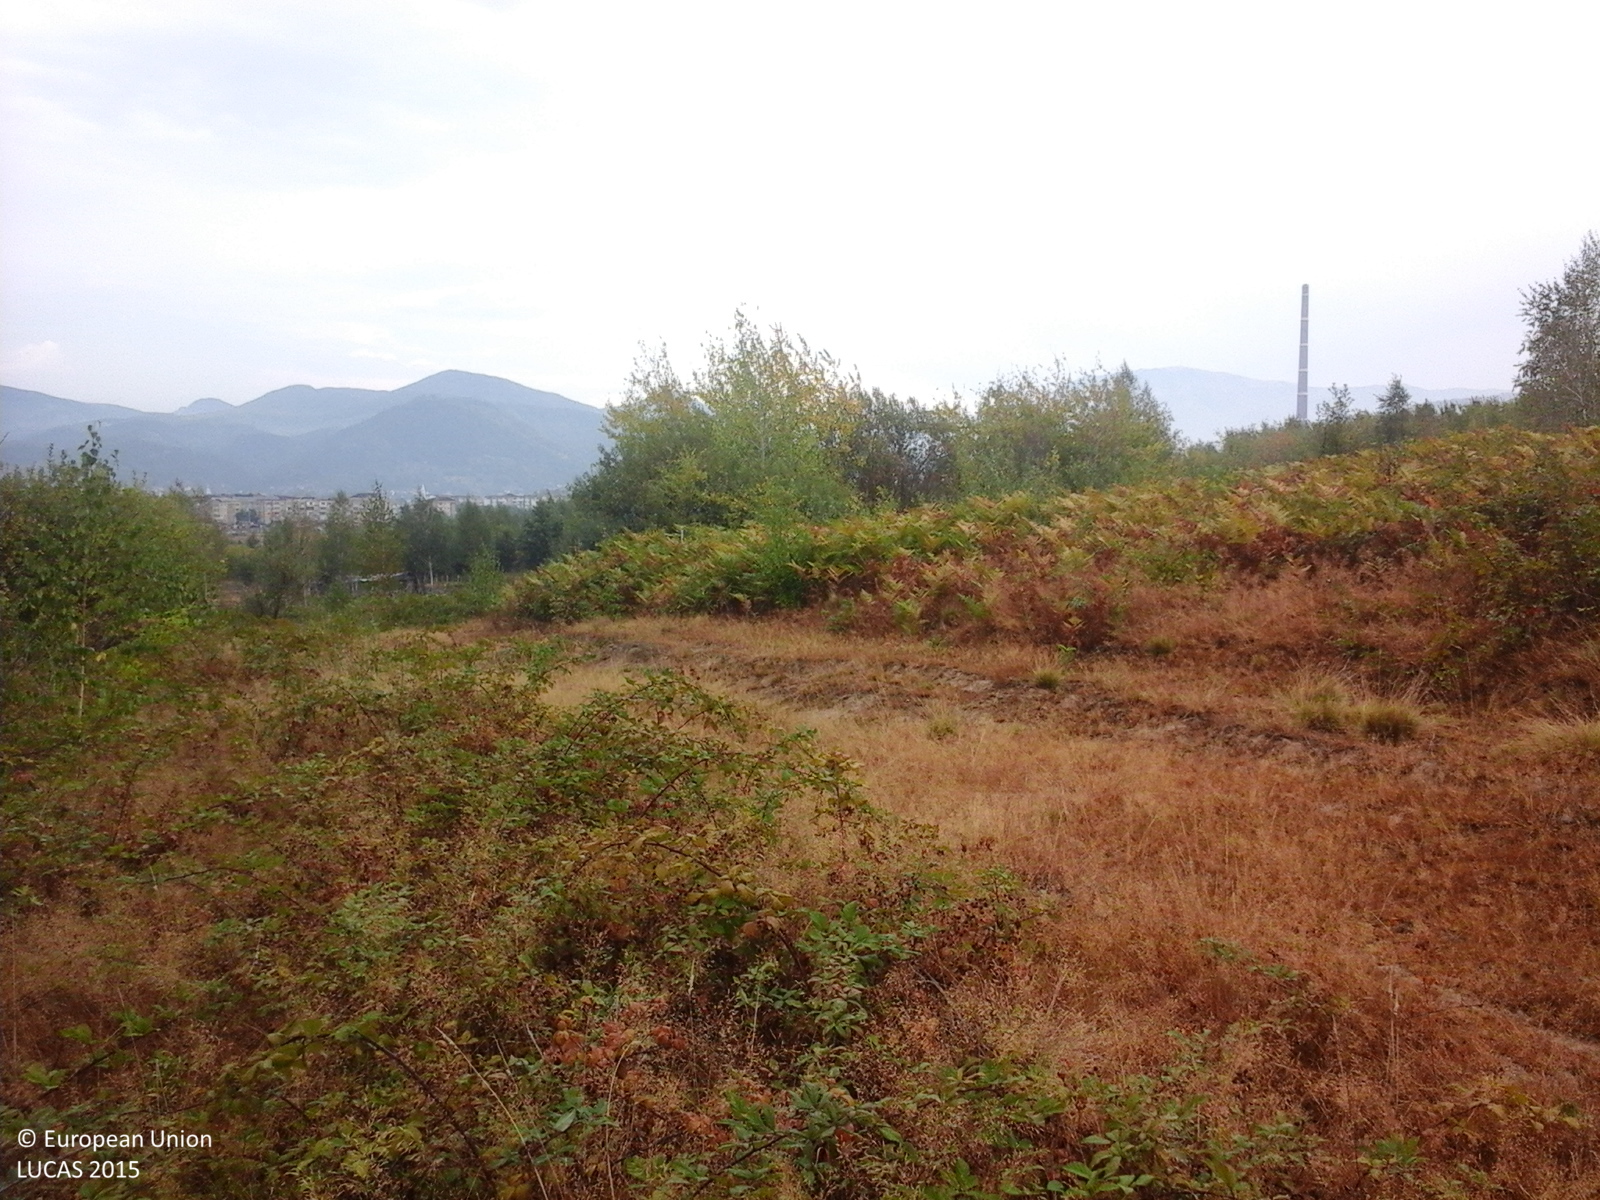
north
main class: Shrubland
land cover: Shrubland with sparse tree cover
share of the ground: > 75 %
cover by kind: shrubs 95 %, broadleaved forest trees 5 %
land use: Semi-natural and natural areas not in use
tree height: < 5 m
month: September
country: RO
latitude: 47.6332
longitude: 23.5846
